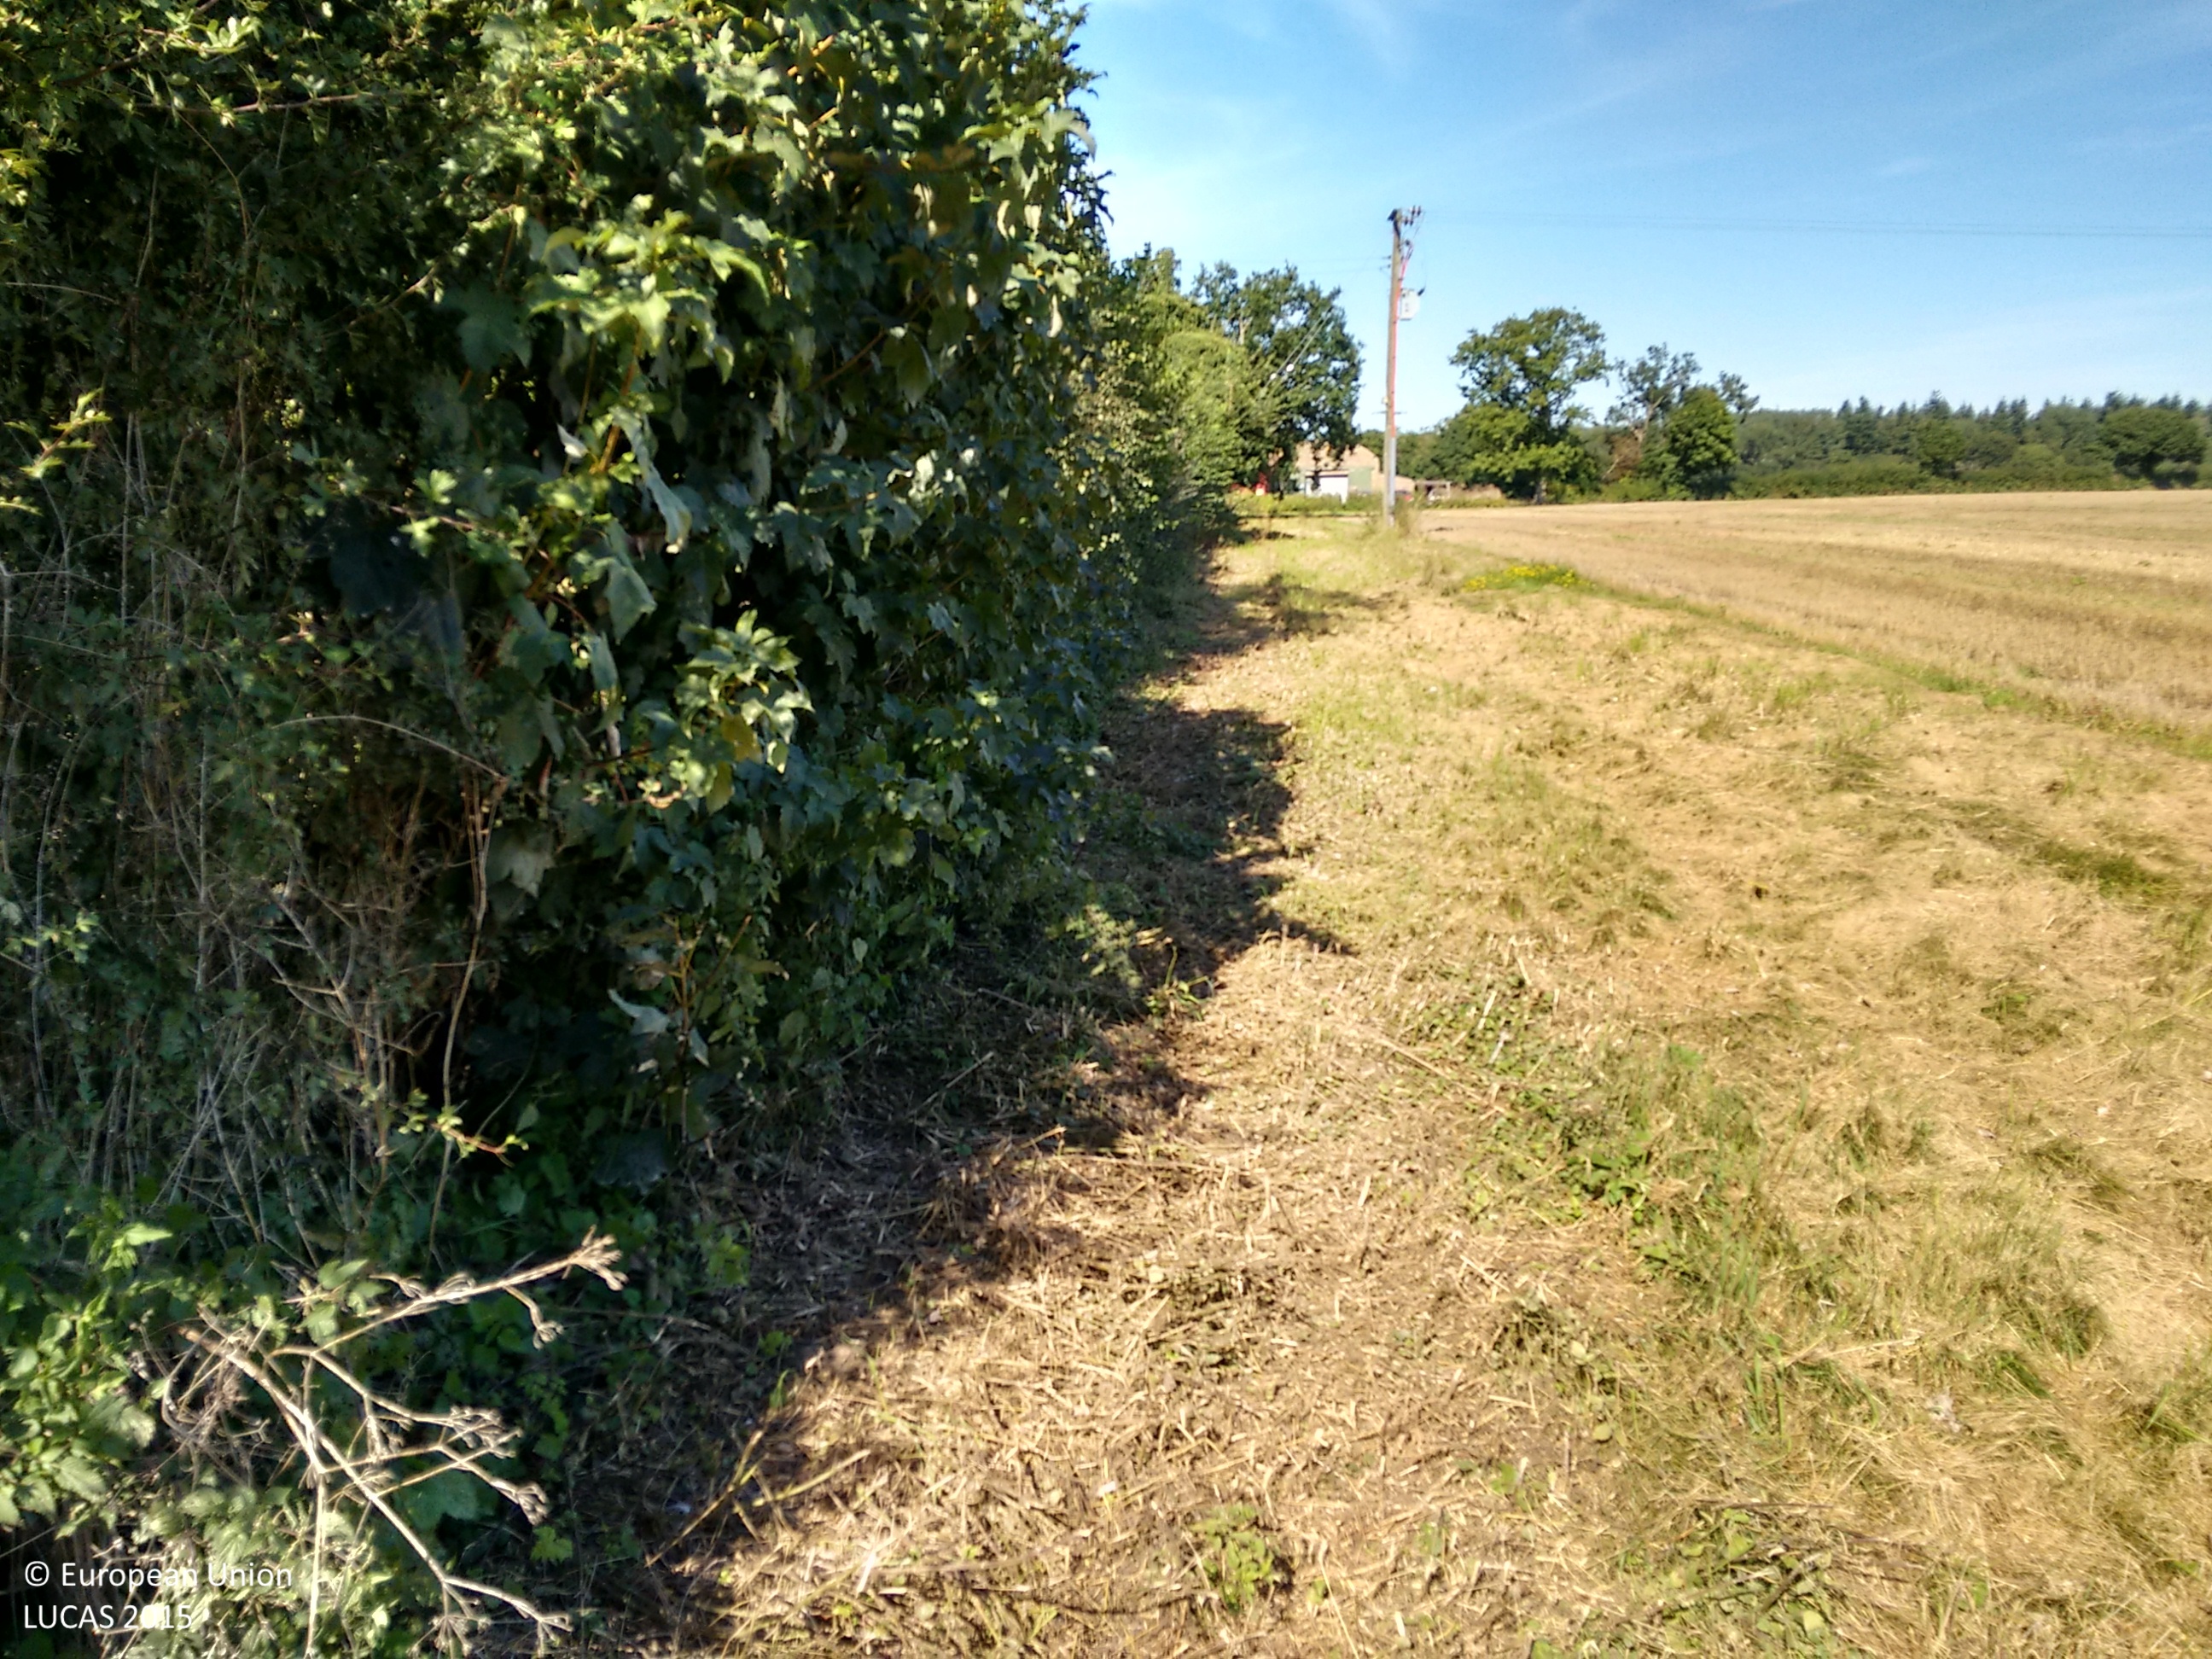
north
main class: Grassland
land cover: Grassland with sparse tree/shrub cover
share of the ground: > 75 %
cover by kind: herbaceous plants 95 %, broadleaved forest trees 5 %
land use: Amenities, museums, leisure
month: September
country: GB
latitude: 52.4946
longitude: 0.8585
